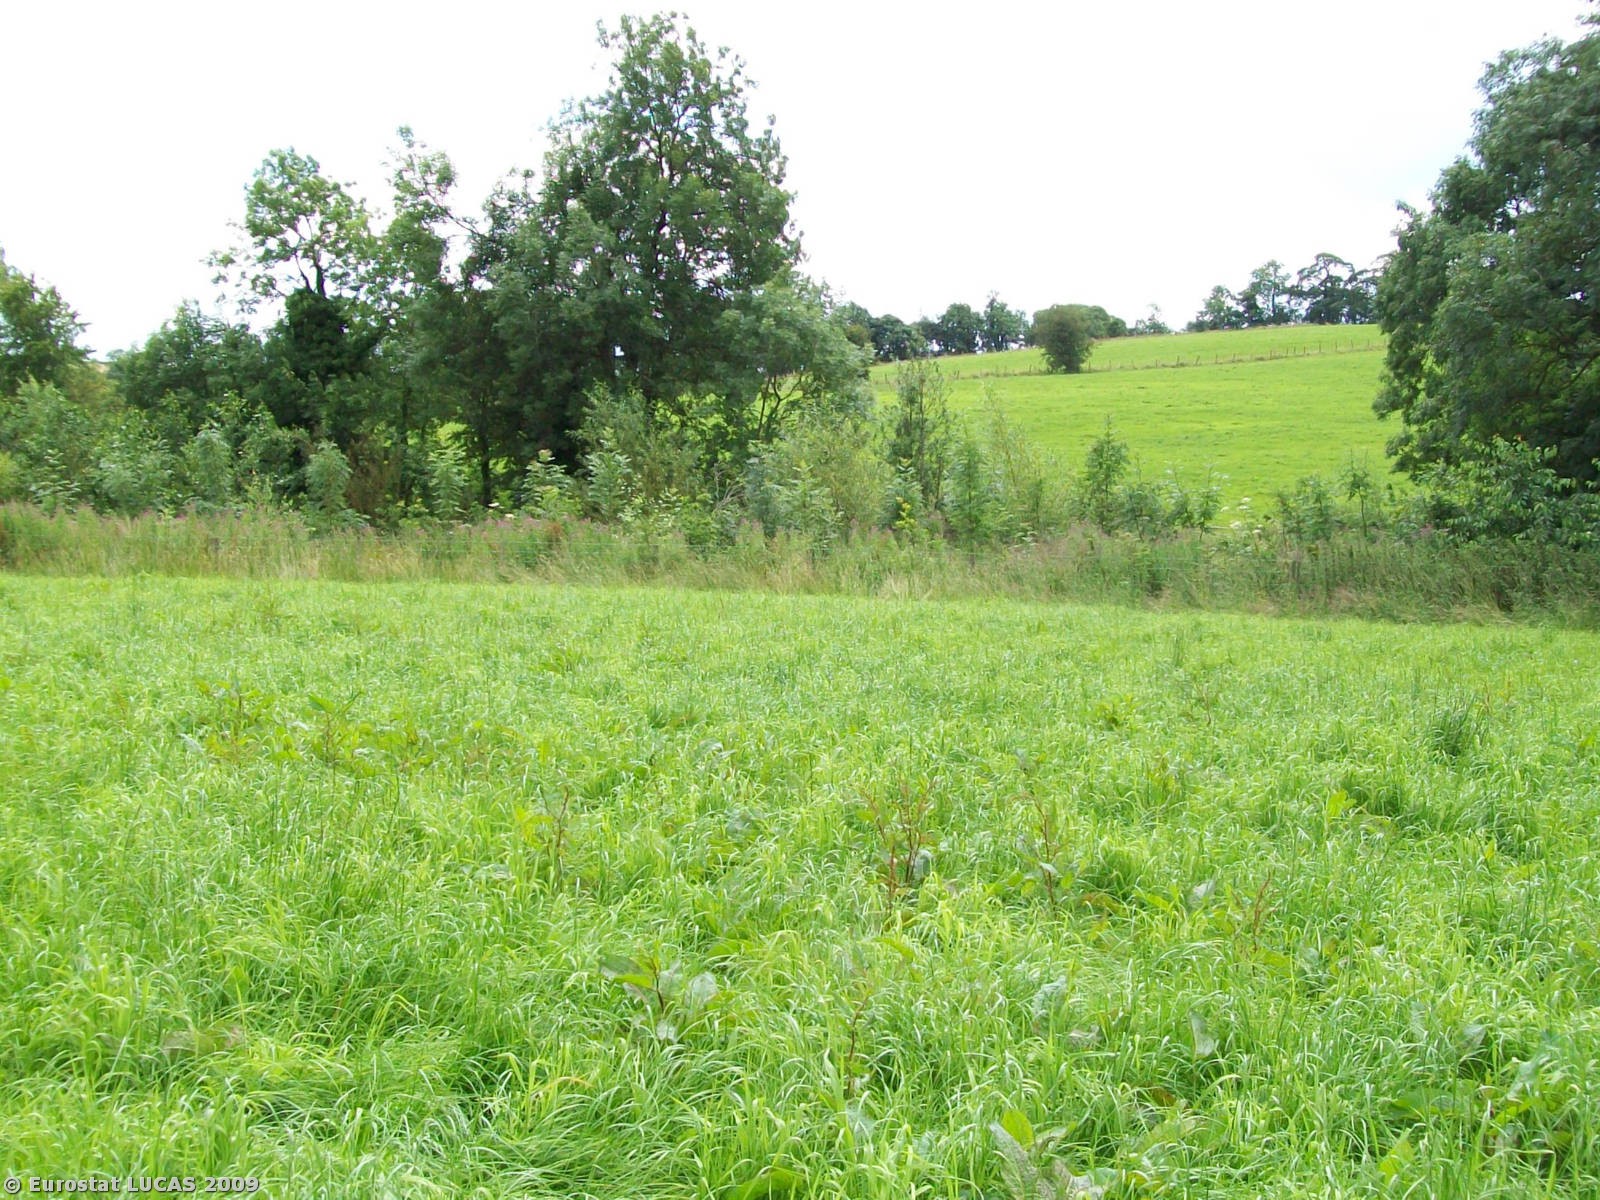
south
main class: Grassland
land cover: Grassland without tree/shrub cover
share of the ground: > 75 %
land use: Agriculture (excluding fallow land and kitchen gardens)
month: July
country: GB
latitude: 54.5842
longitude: -6.7019
